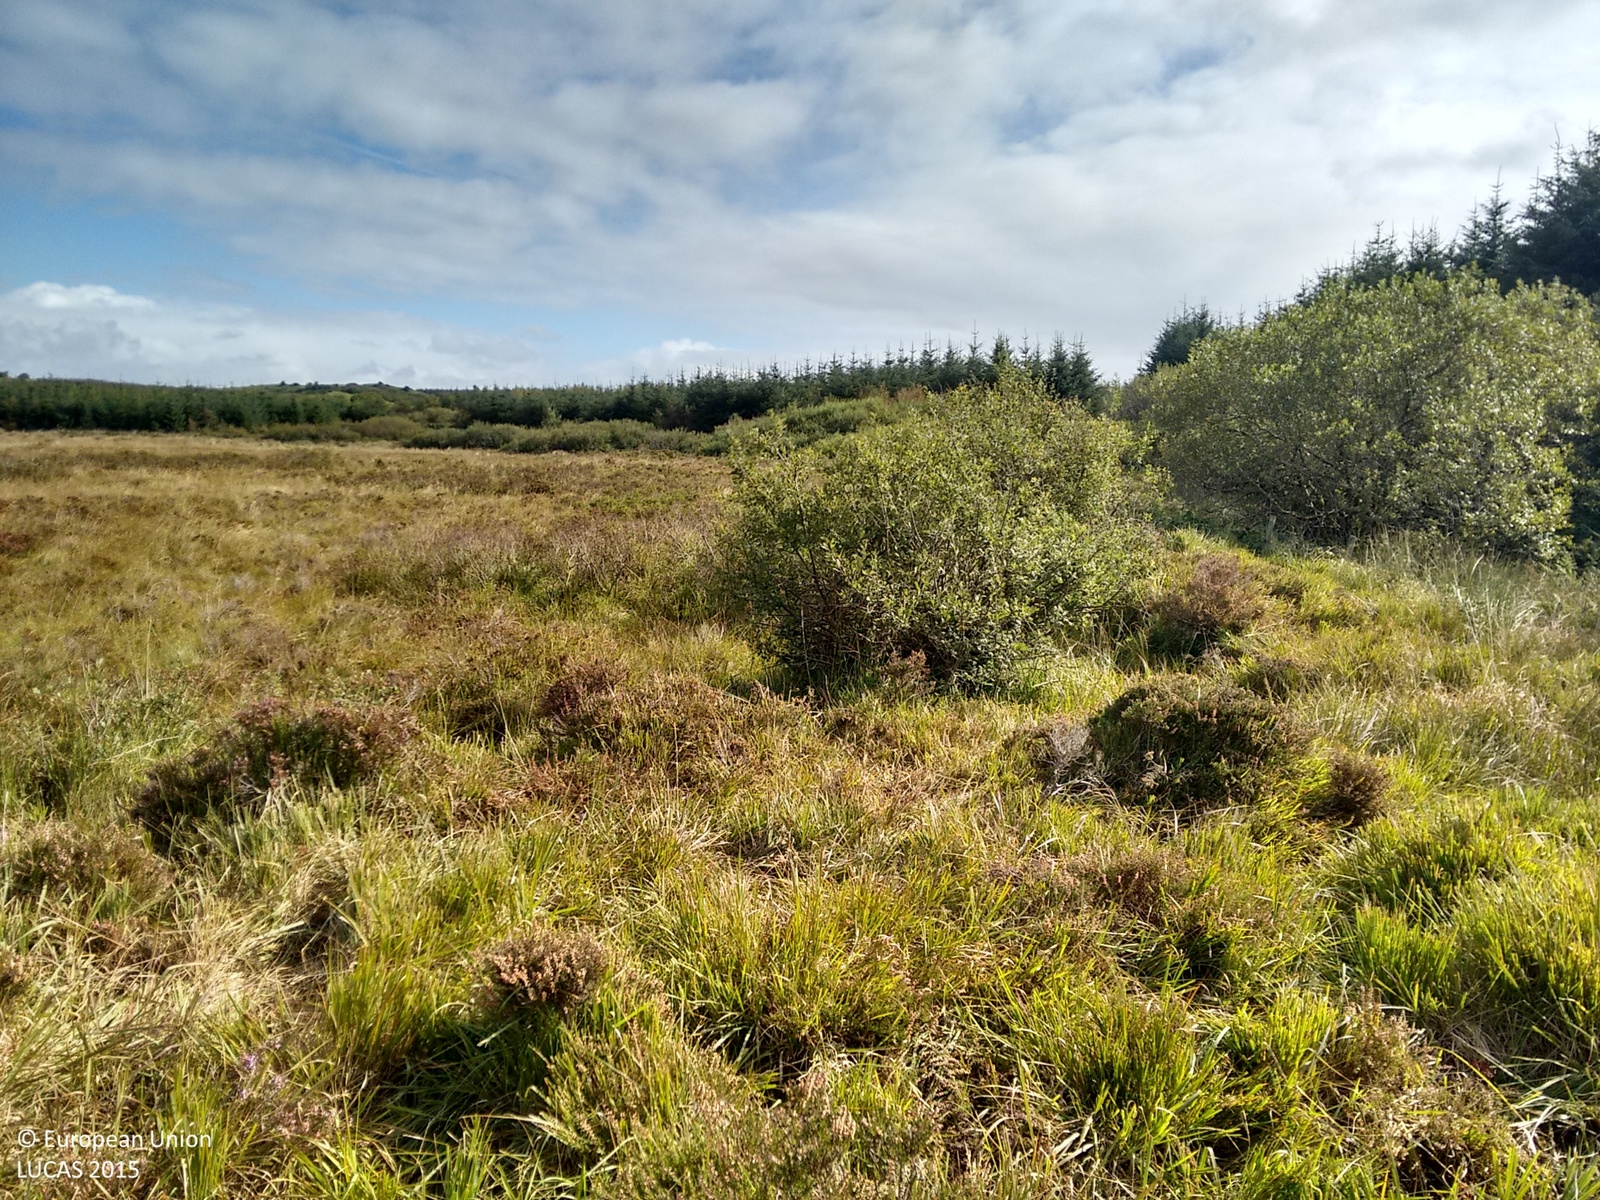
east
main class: Grassland
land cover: Grassland without tree/shrub cover
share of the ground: > 75 %
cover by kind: herbaceous plants 100 %
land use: Agriculture (excluding fallow land and kitchen gardens)
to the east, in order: Grassland without tree/shrub cover; Shrubland without tree cover; Grassland without tree/shrub cover; Shrubland without tree cover; Other coniferous woodland
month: September
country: IE
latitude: 52.7568
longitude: -9.3873
